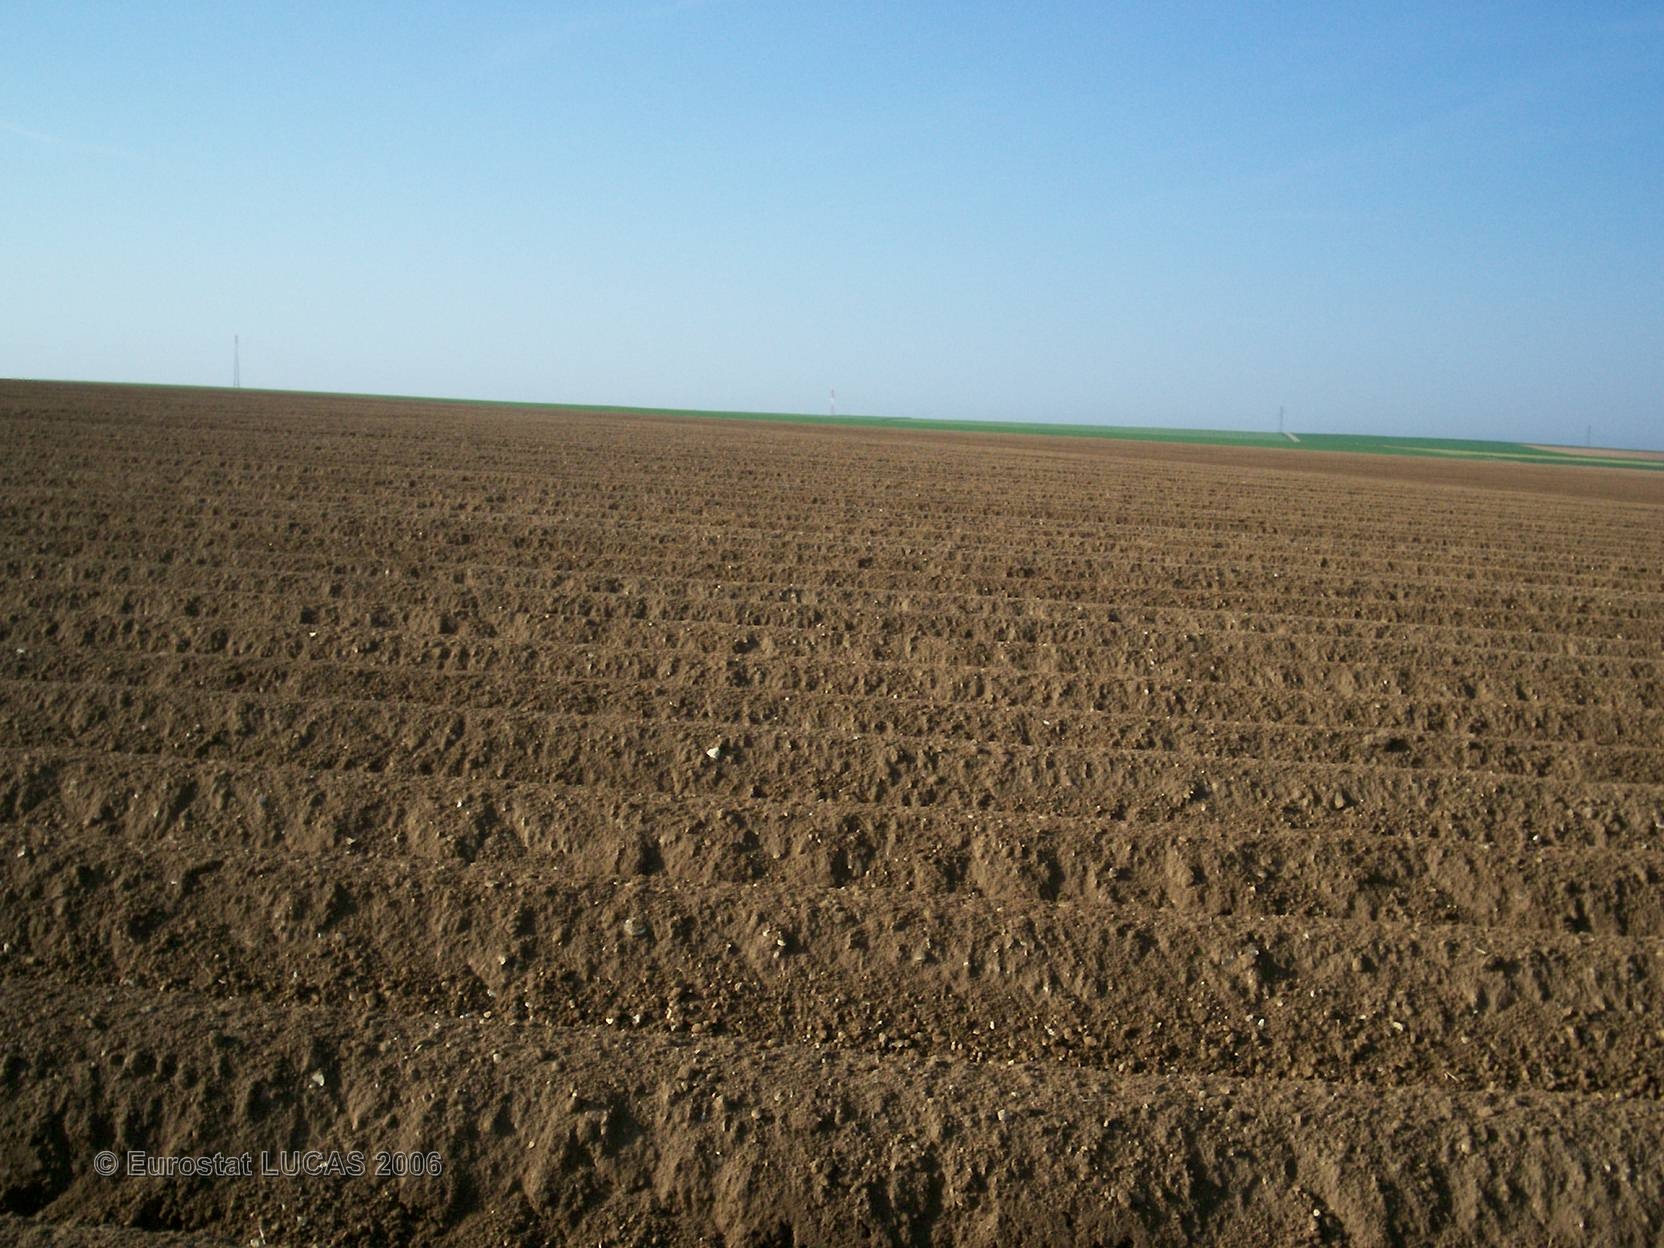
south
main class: Cropland
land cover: Potatoes
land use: Agriculture (excluding fallow land and kitchen gardens)
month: April
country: FR
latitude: 48.4620
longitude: 4.4389
